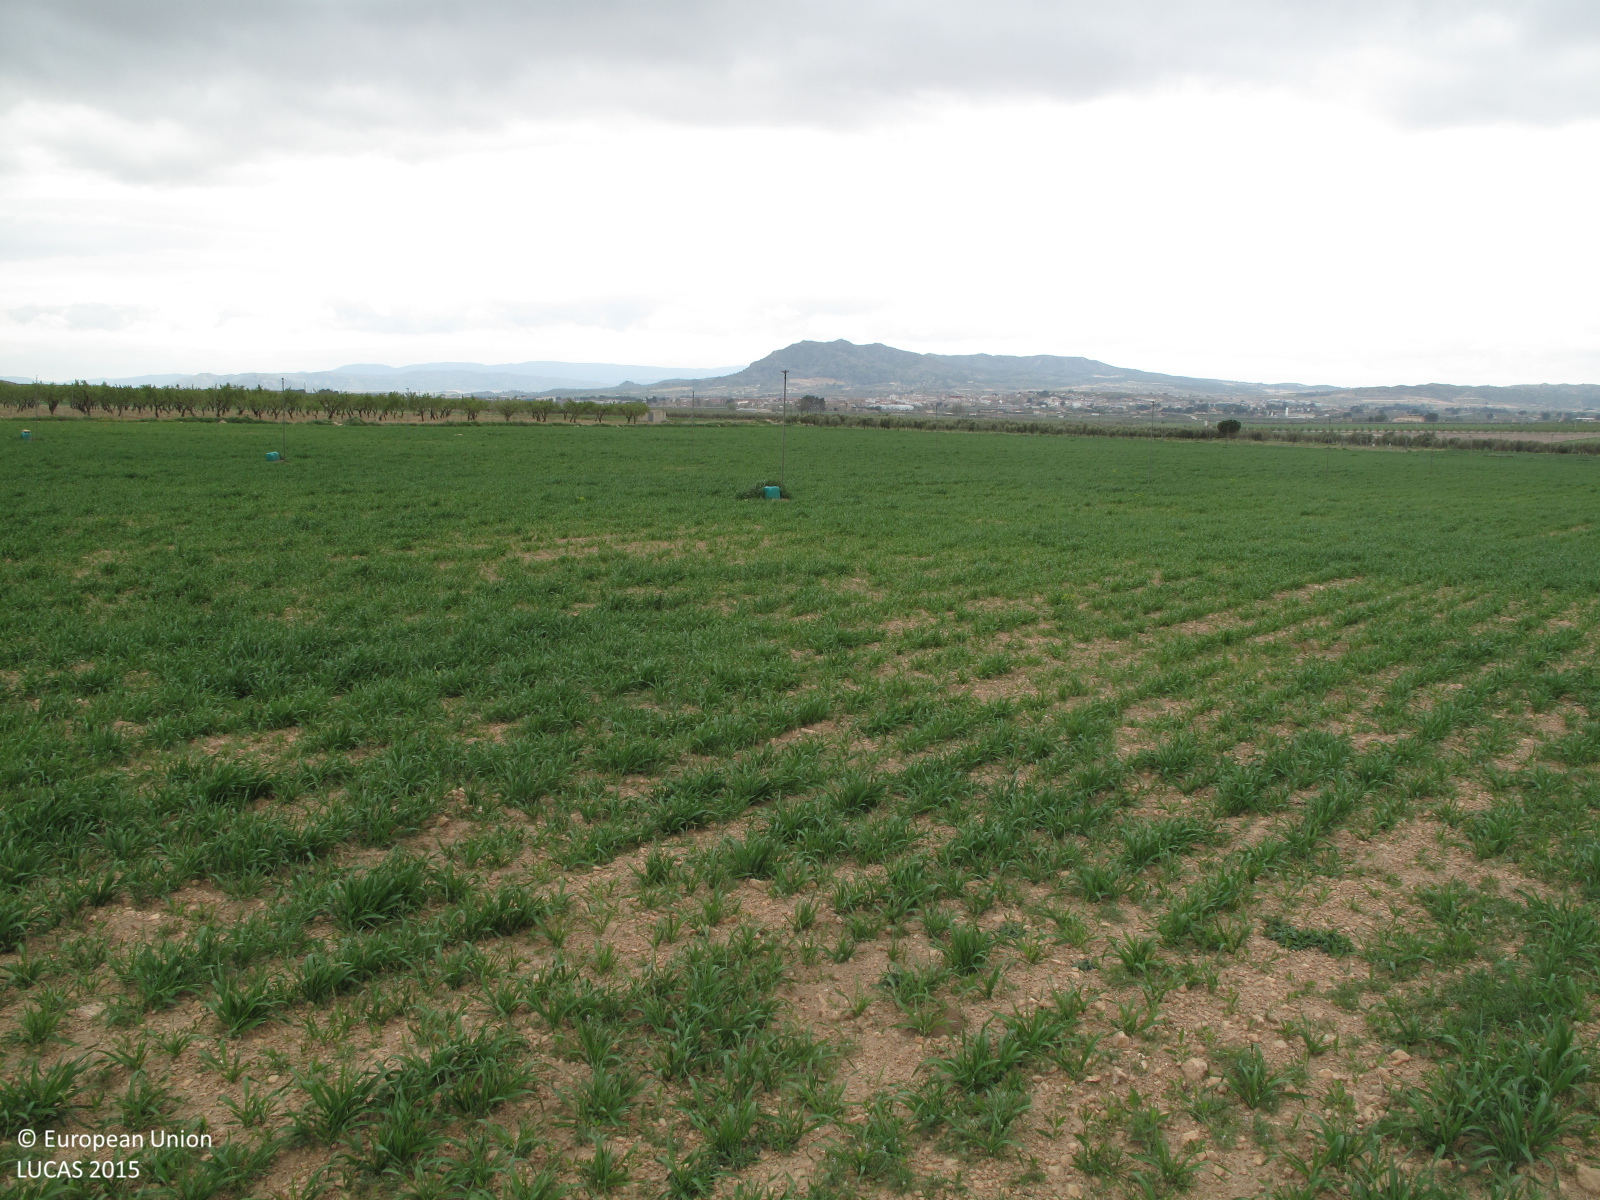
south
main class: Cropland
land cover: Barley
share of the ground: 50 - 75 %
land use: Agriculture (excluding fallow land and kitchen gardens)
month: April
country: ES
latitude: 38.7366
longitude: -0.9785
